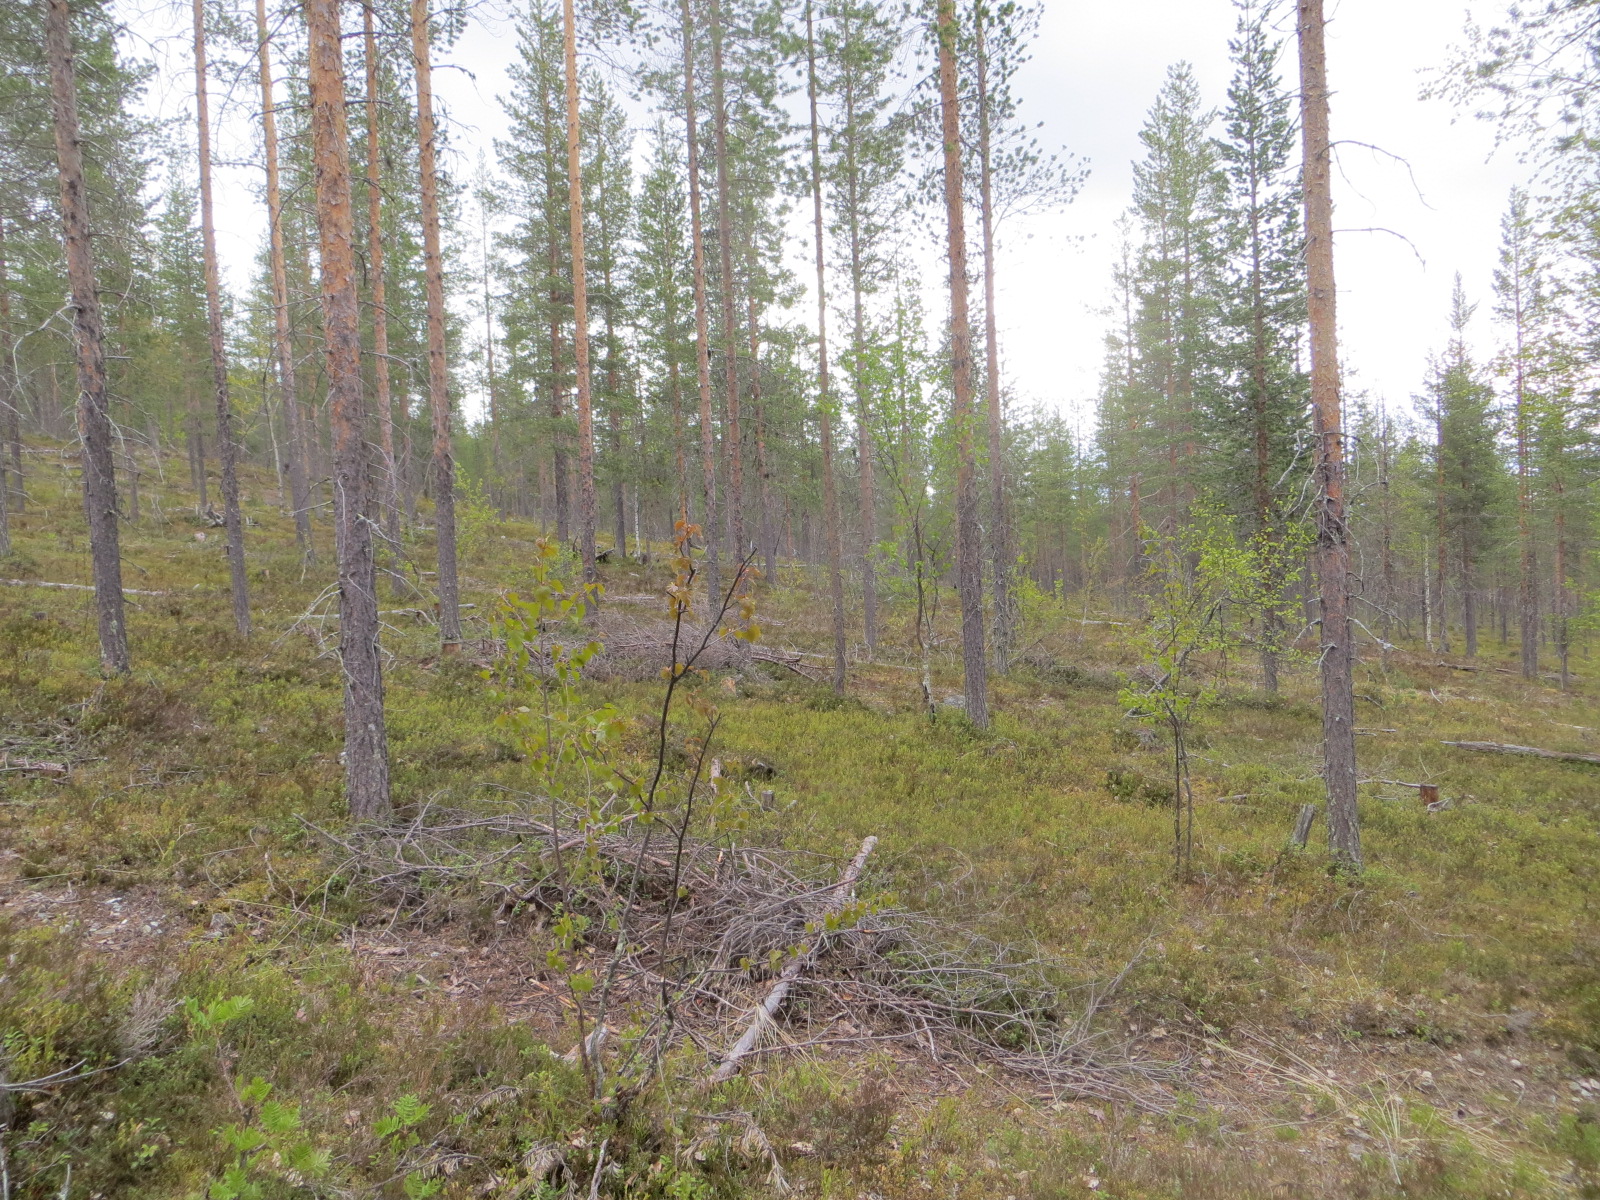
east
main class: Woodland
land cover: Pine dominated coniferous woodland
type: boreal forest
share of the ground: 50 - 75 %
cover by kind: coniferous forest trees 65 %, shrubs 15 %, broadleaved forest trees 10 %, herbaceous plants 5 %, lichens and mosses 5 %
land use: Forestry
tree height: > 5 m
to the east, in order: Pine dominated coniferous woodland
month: June
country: FI
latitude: 67.5705
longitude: 25.7657
